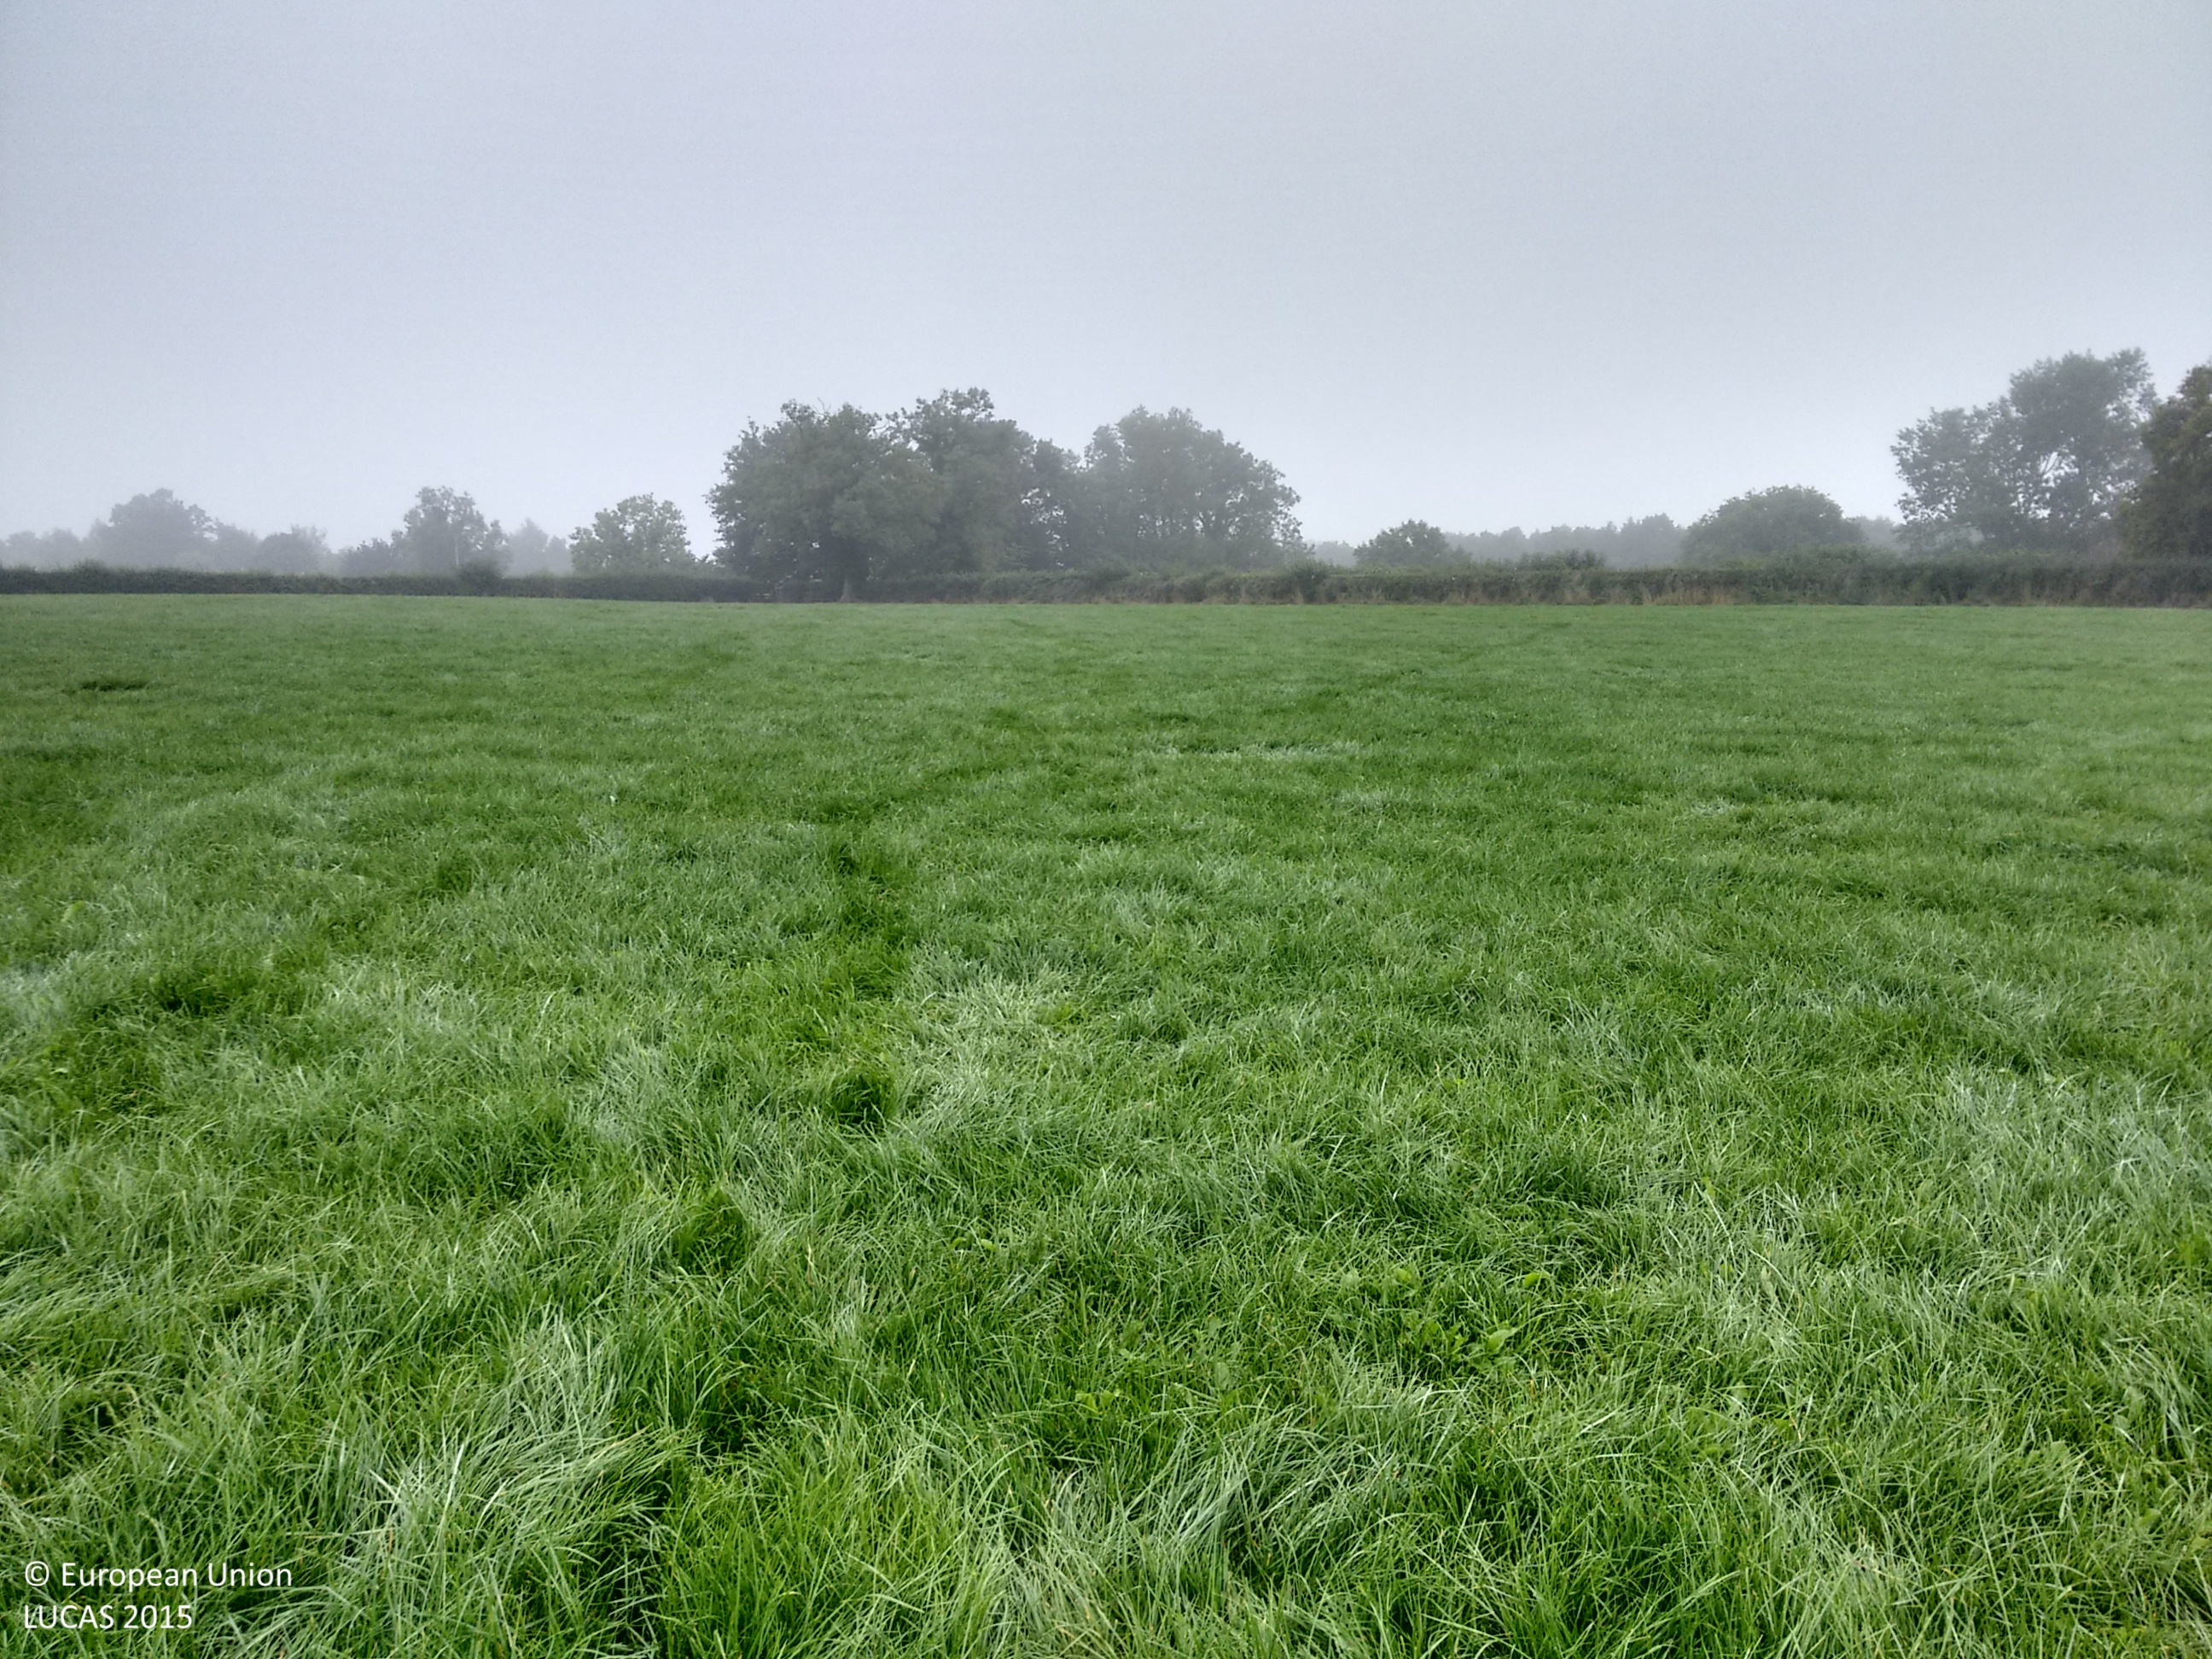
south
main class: Grassland
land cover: Grassland without tree/shrub cover
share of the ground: > 75 %
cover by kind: herbaceous plants 100 %
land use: Agriculture (excluding fallow land and kitchen gardens)
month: September
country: GB
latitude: 52.7895
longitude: -2.9903
